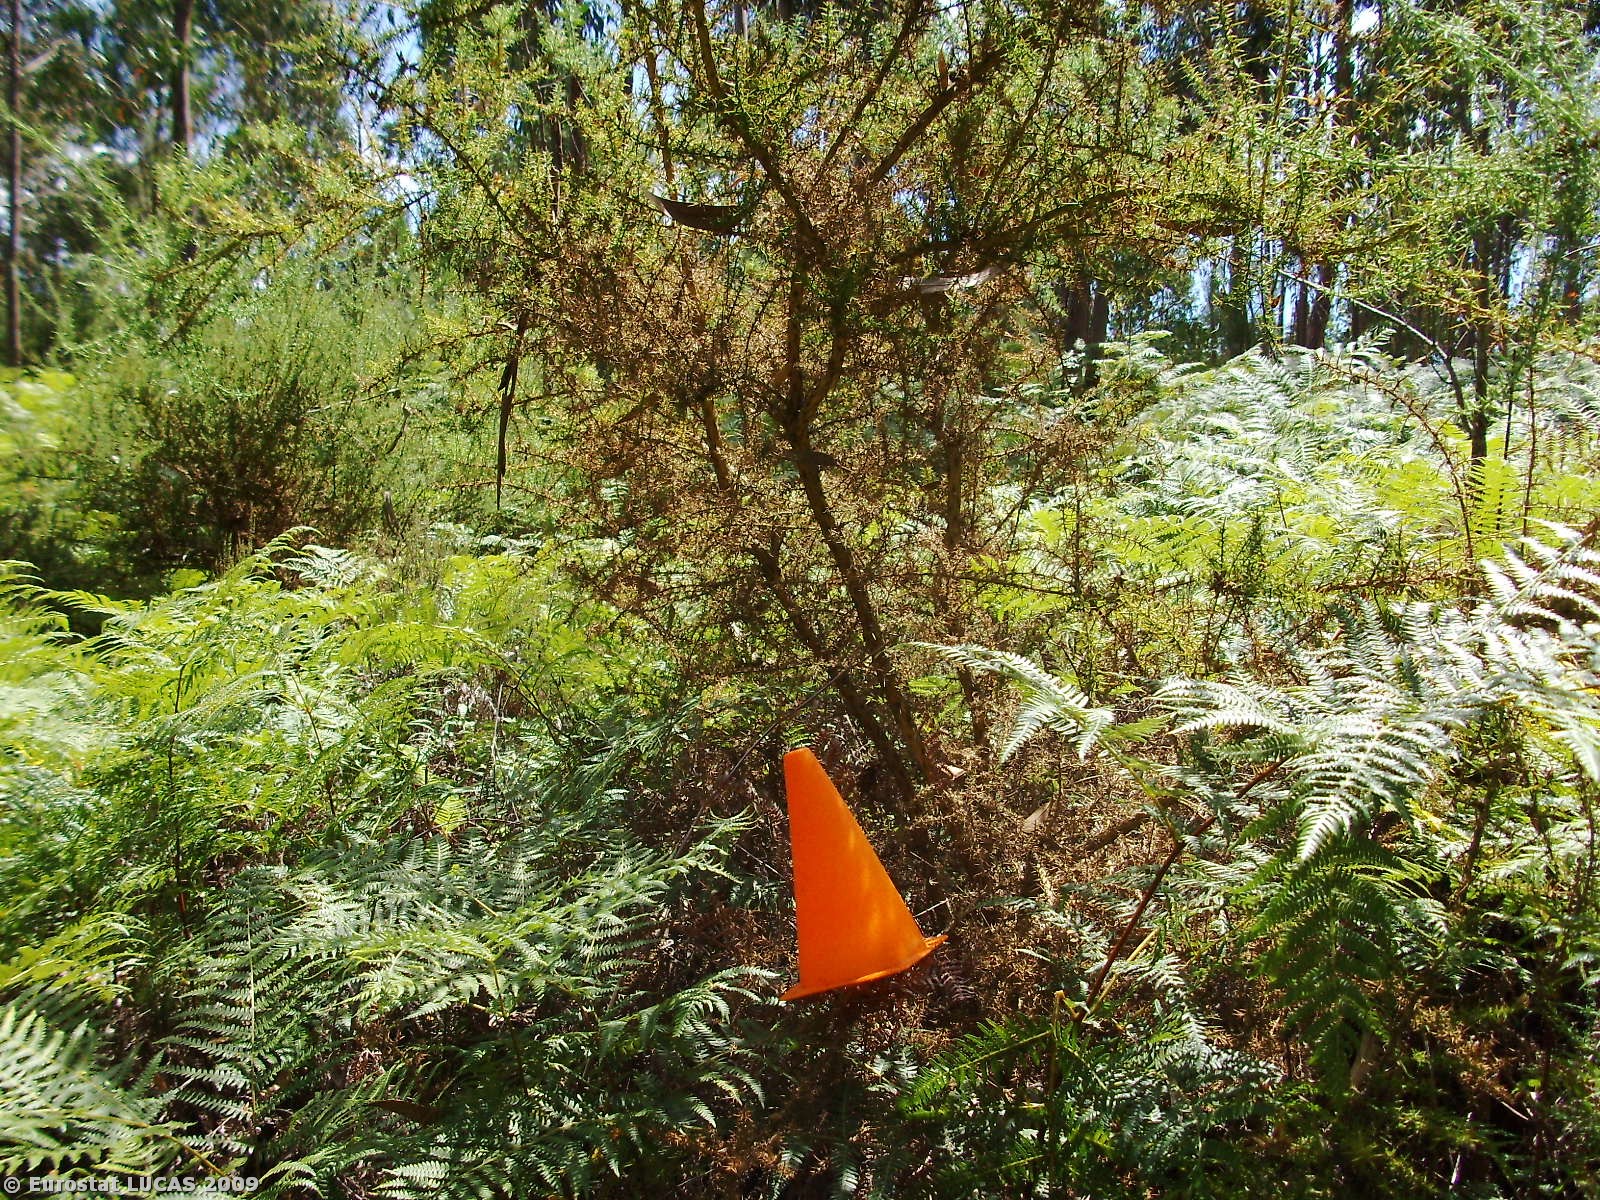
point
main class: Woodland
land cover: Broadleaved woodland
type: plantations and self-sown exotic forest
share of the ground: 10 - 25 %
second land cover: Shrubland with sparse tree cover
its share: > 75 %
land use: Forestry
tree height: > 5 m
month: July
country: PT
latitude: 39.7339
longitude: -8.8612
